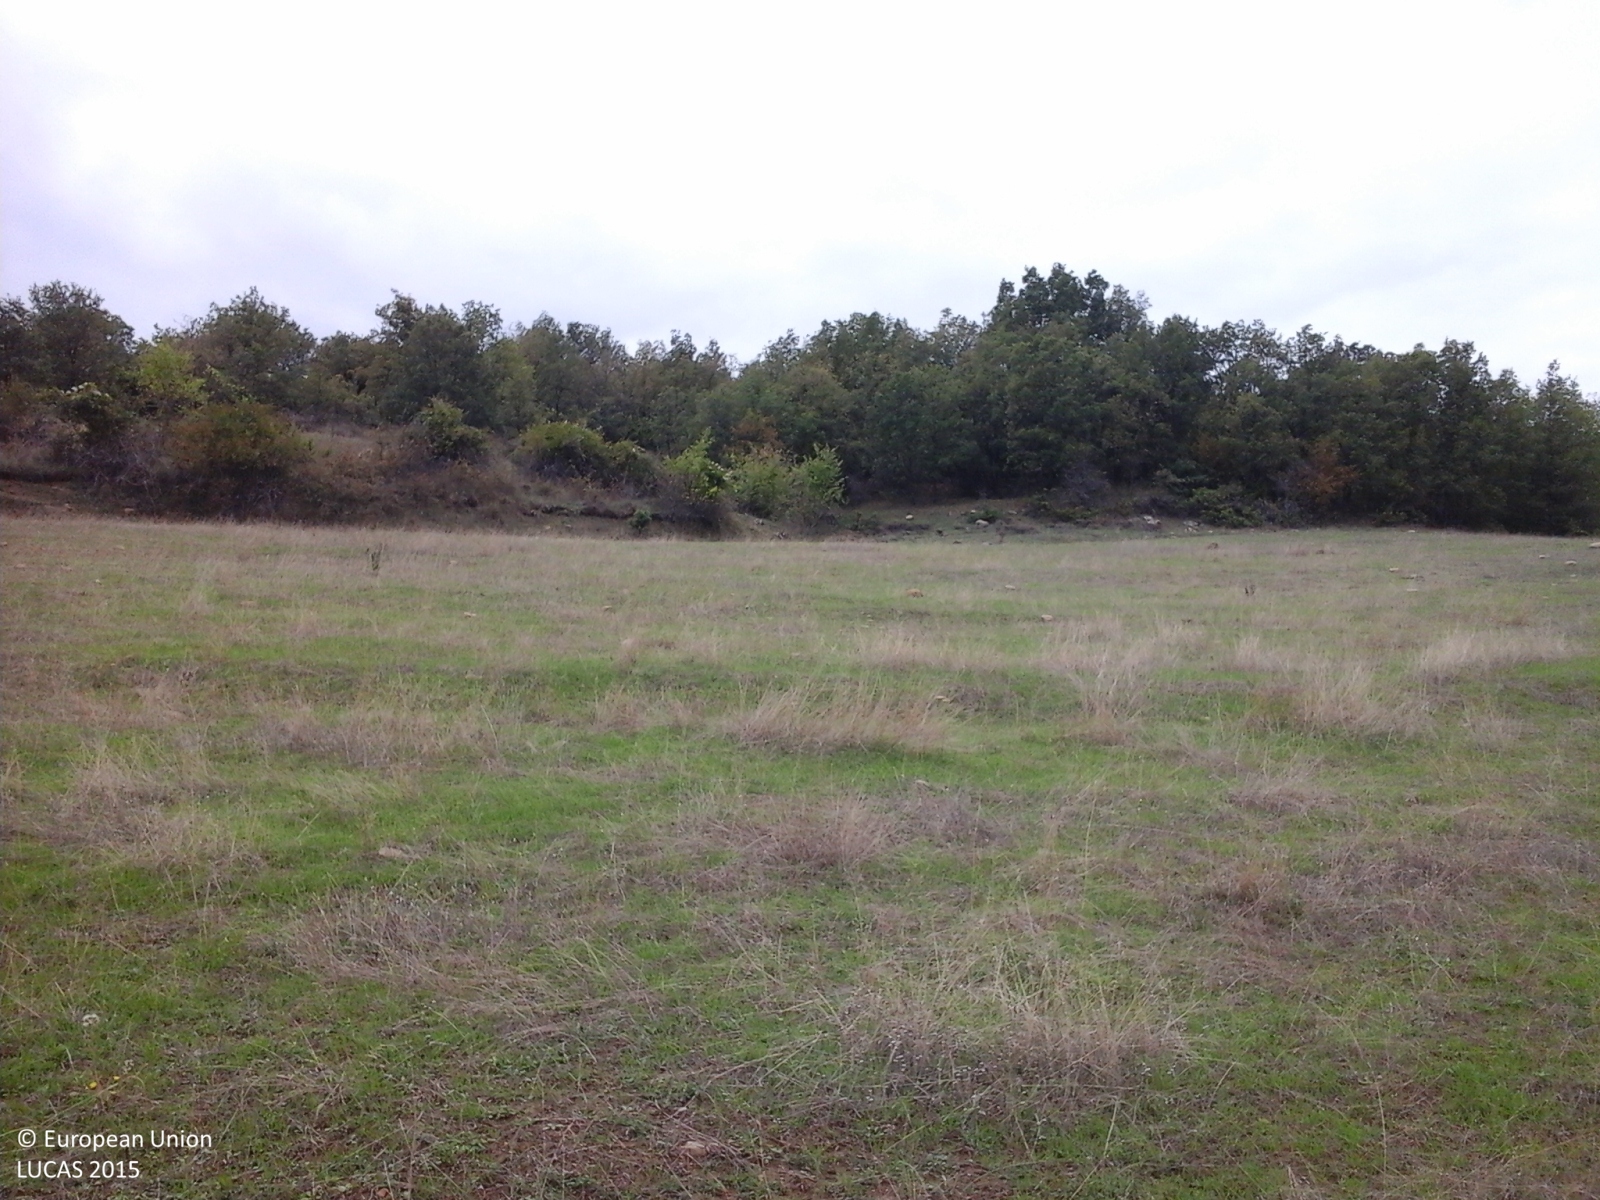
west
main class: Grassland
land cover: Spontaneously vegetated surfaces
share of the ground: > 75 %
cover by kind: herbaceous plants 75 %, unconsolidated bare surface 25 %
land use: Fallow land
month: October
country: GR
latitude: 40.3839
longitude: 21.0955
